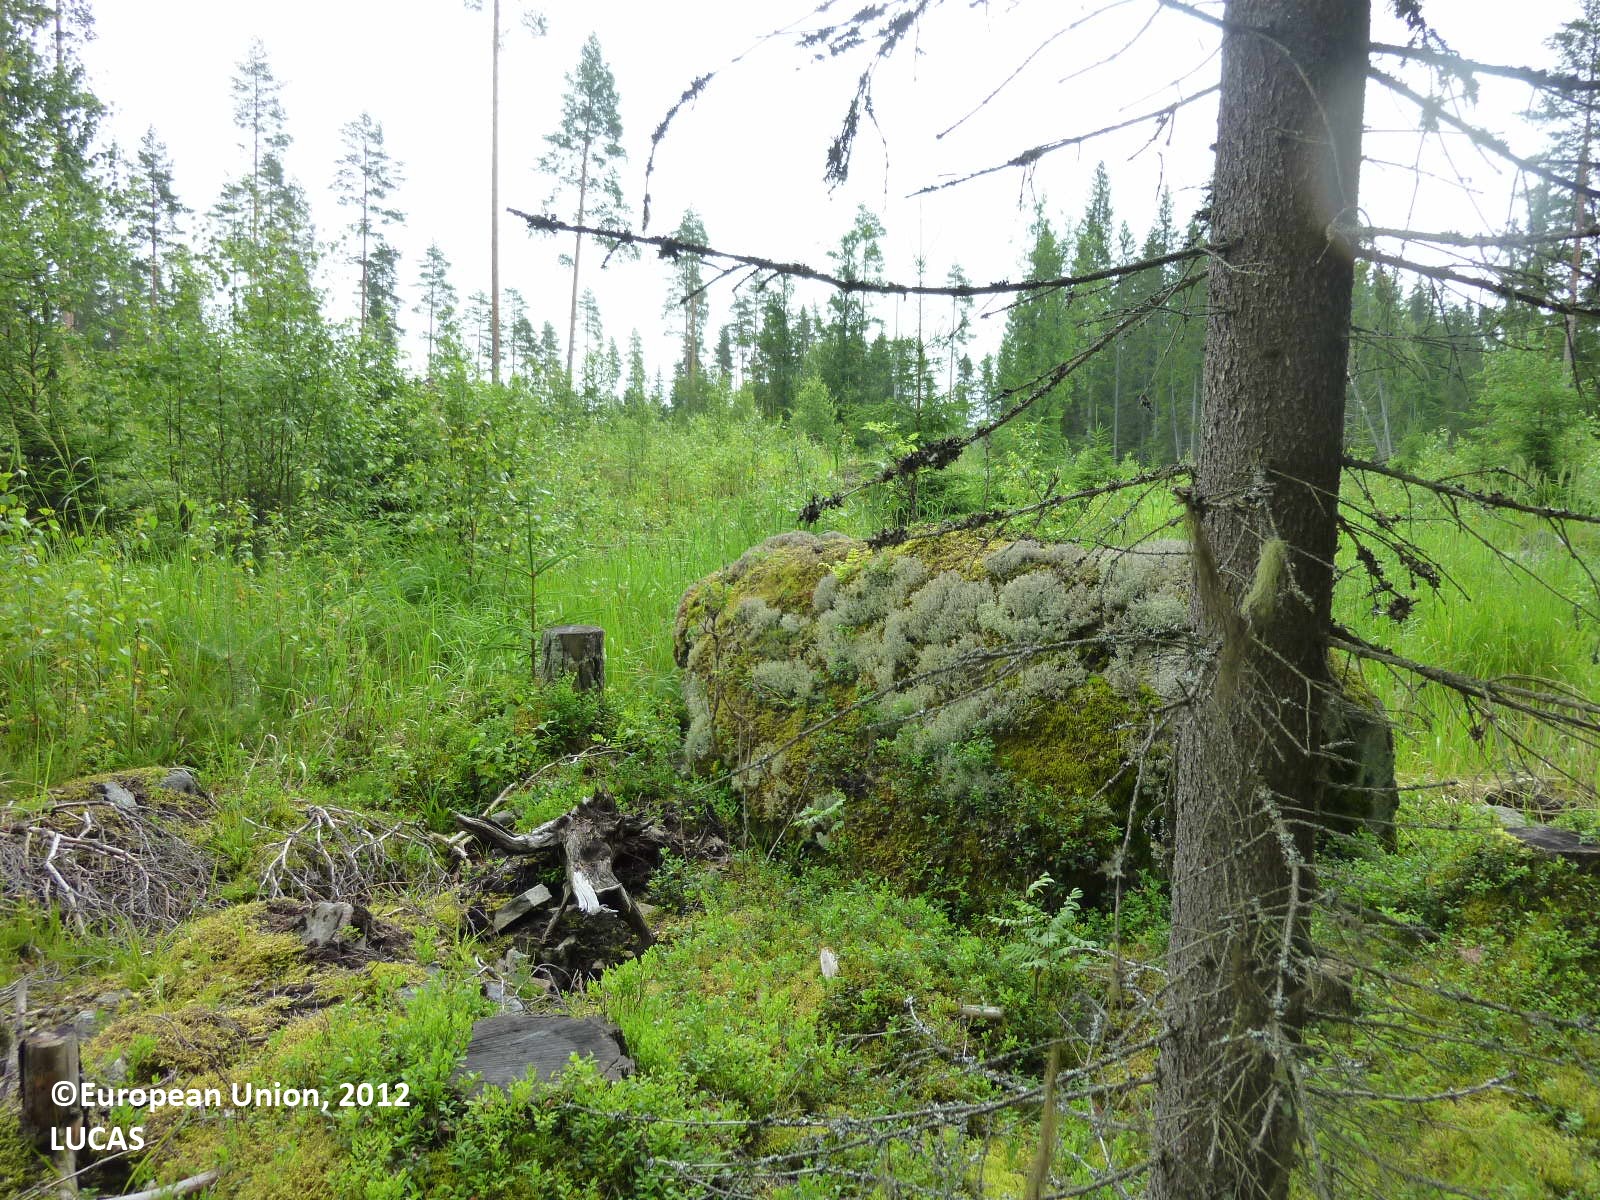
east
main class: Woodland
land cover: Spruce dominated coniferous woodland
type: boreal forest
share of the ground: > 75 %
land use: Forestry
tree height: > 5 m
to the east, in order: Spruce dominated coniferous woodland; Broadleaved woodland; Pine dominated mixed woodland; Ditches and canals; Broadleaved woodland
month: July
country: FI
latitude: 61.6135
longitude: 22.0676
